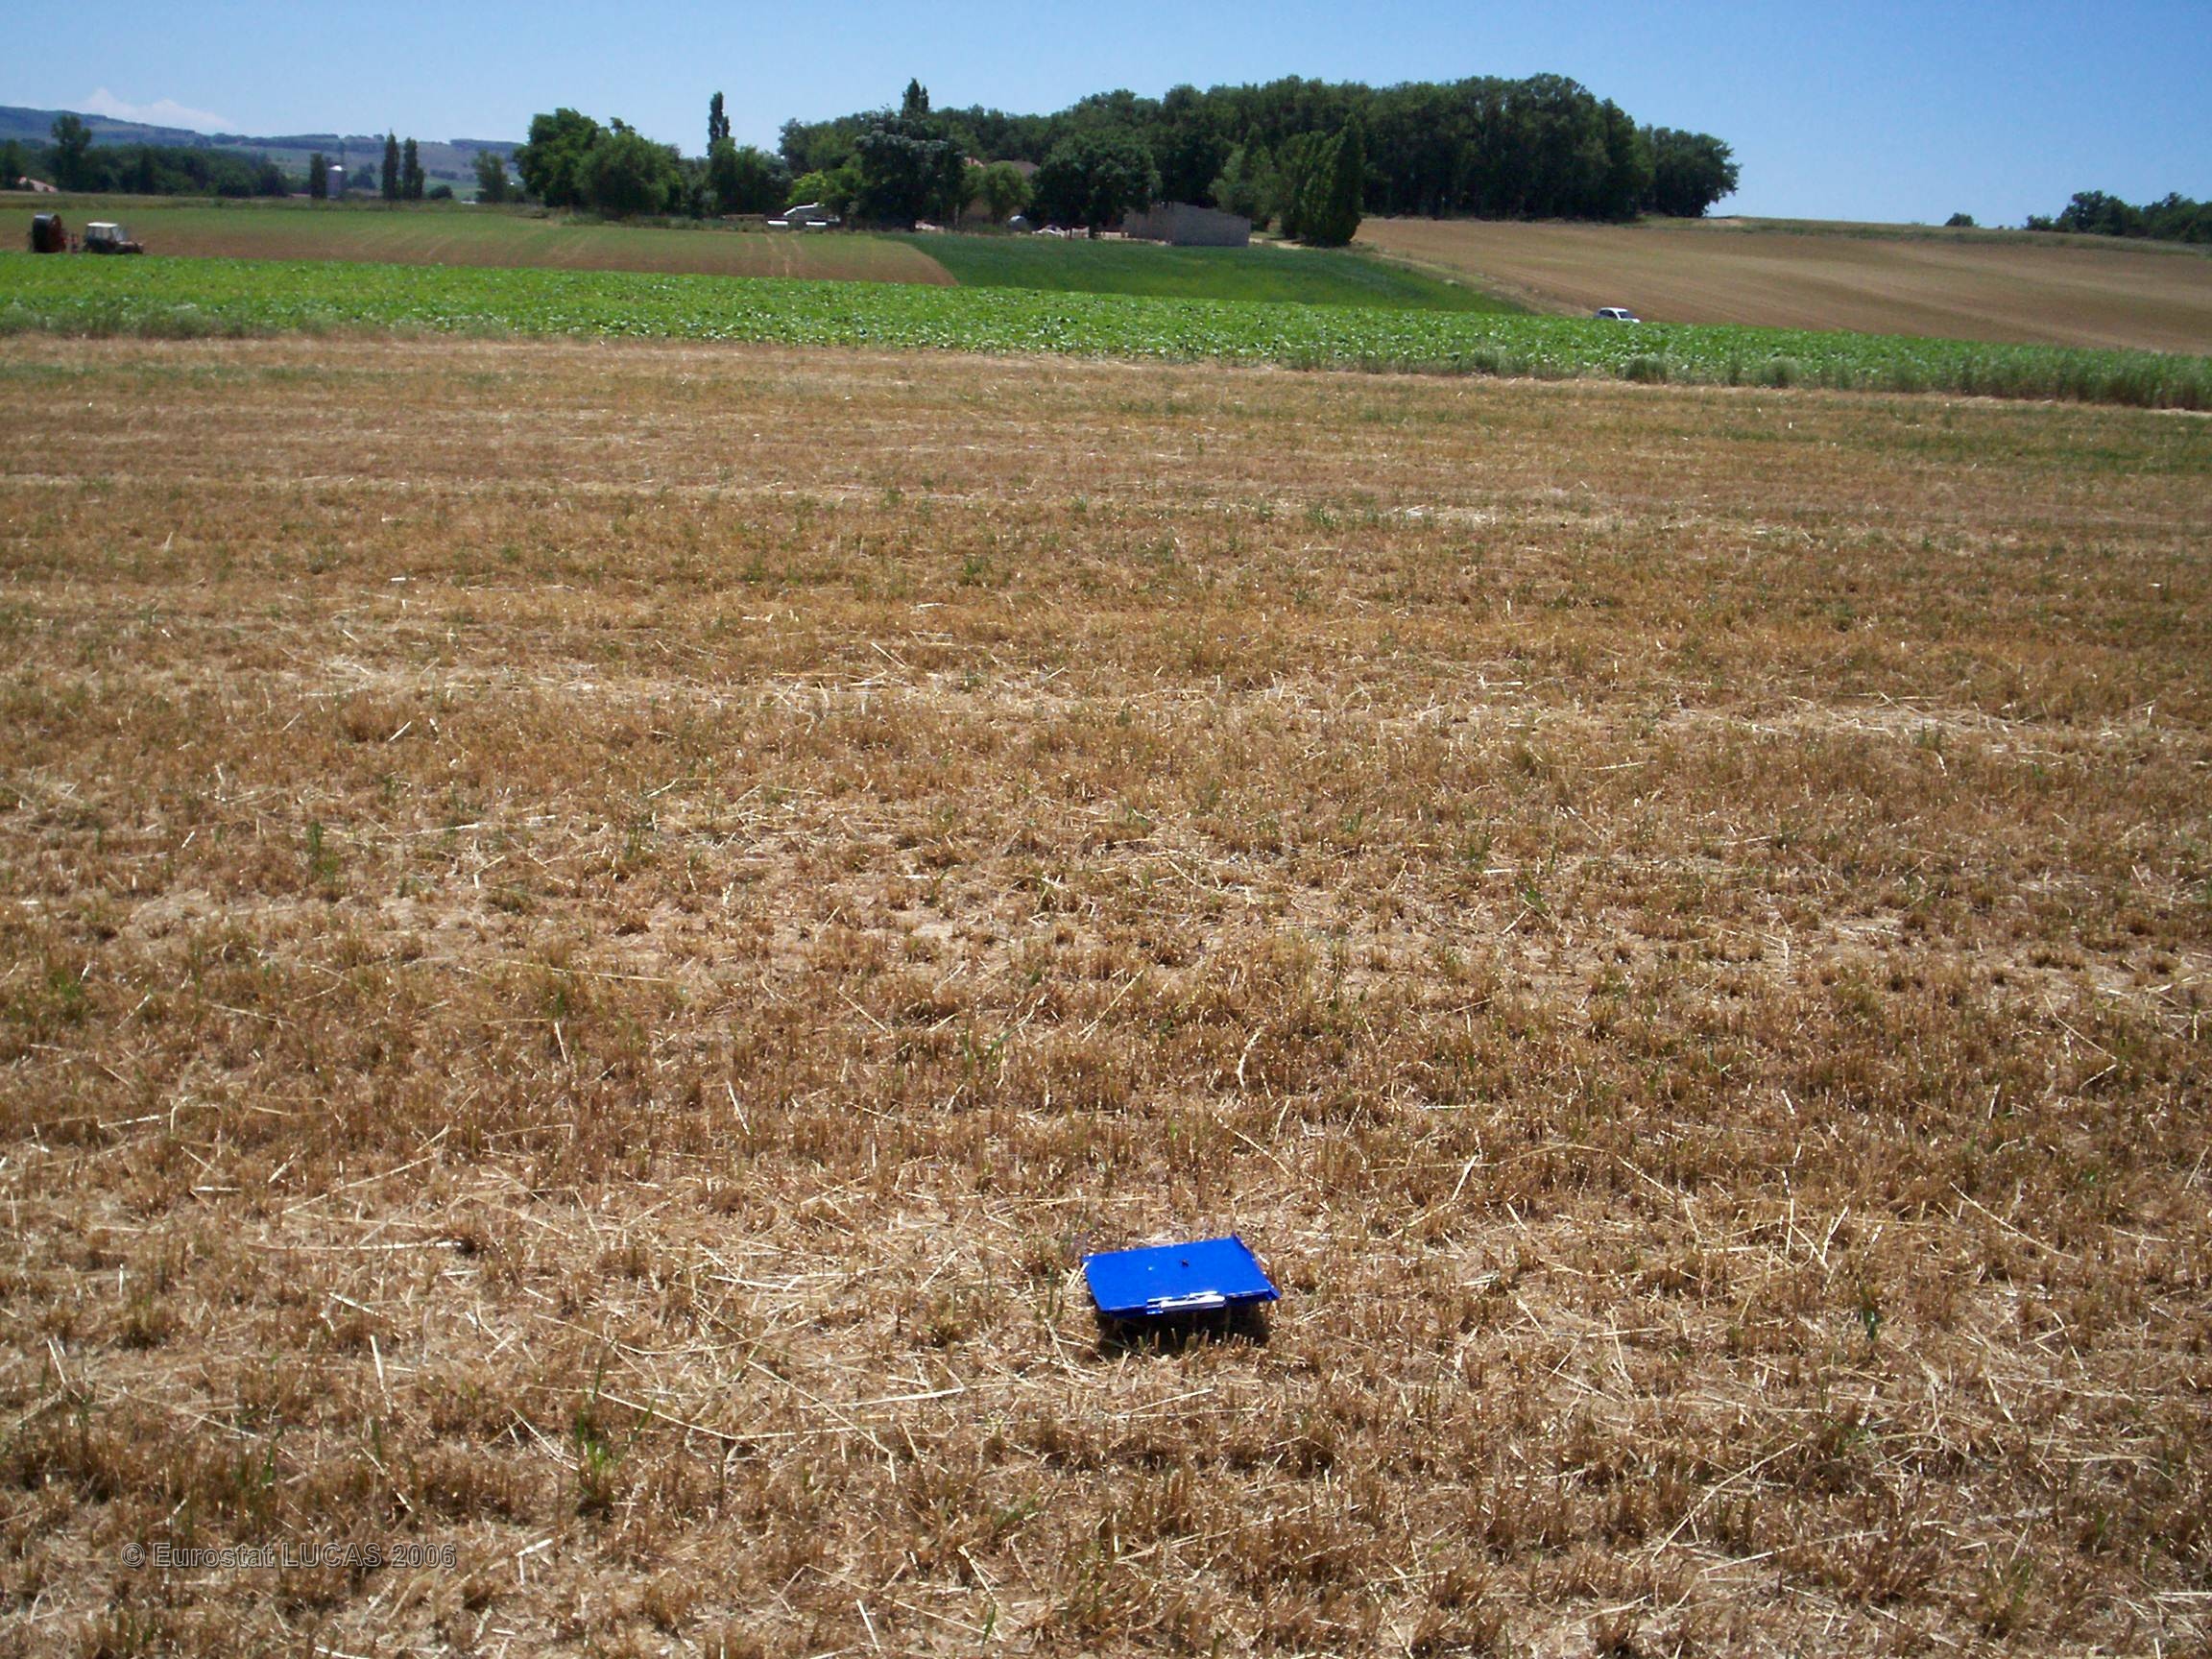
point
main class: Grassland
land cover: Grassland without tree/shrub cover
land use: Agriculture (excluding fallow land and kitchen gardens)
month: June
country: FR
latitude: 43.9961
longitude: 0.8066
